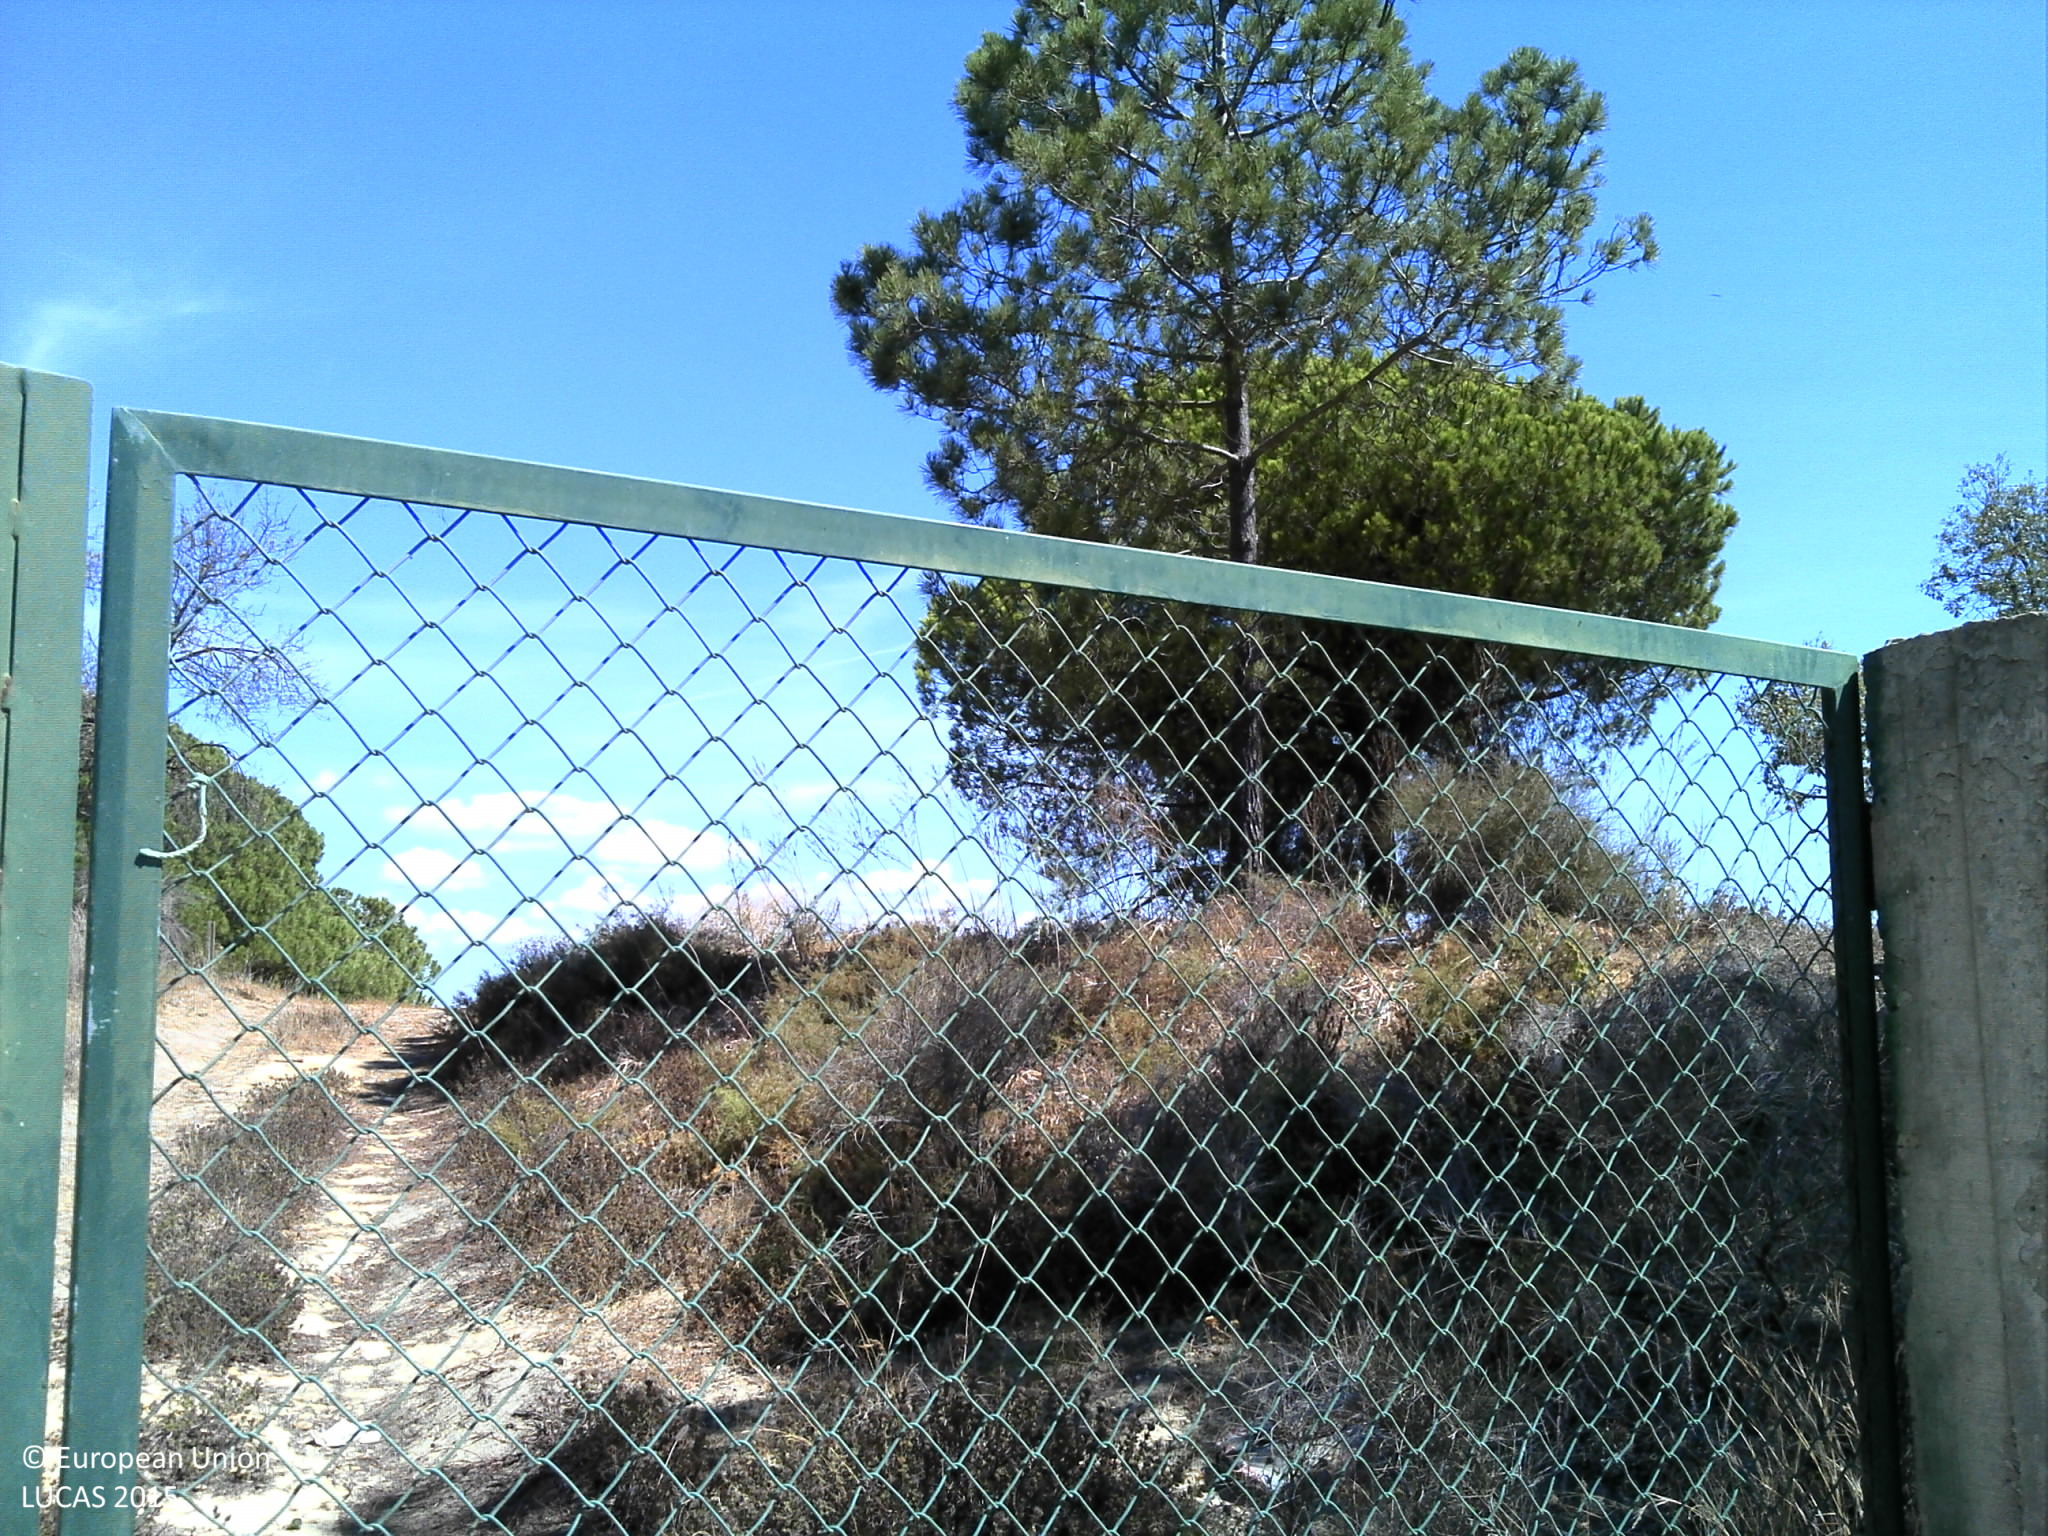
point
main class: Woodland
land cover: Pine dominated coniferous woodland
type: coniferous forest of the mediterranean region
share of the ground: 10 - 25 %
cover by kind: herbaceous plants 45 %, coniferous forest trees 25 %, unconsolidated bare surface 25 %, shrubs 5 %
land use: Forestry
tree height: > 5 m
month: September
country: PT
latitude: 37.0715
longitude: -8.0881
